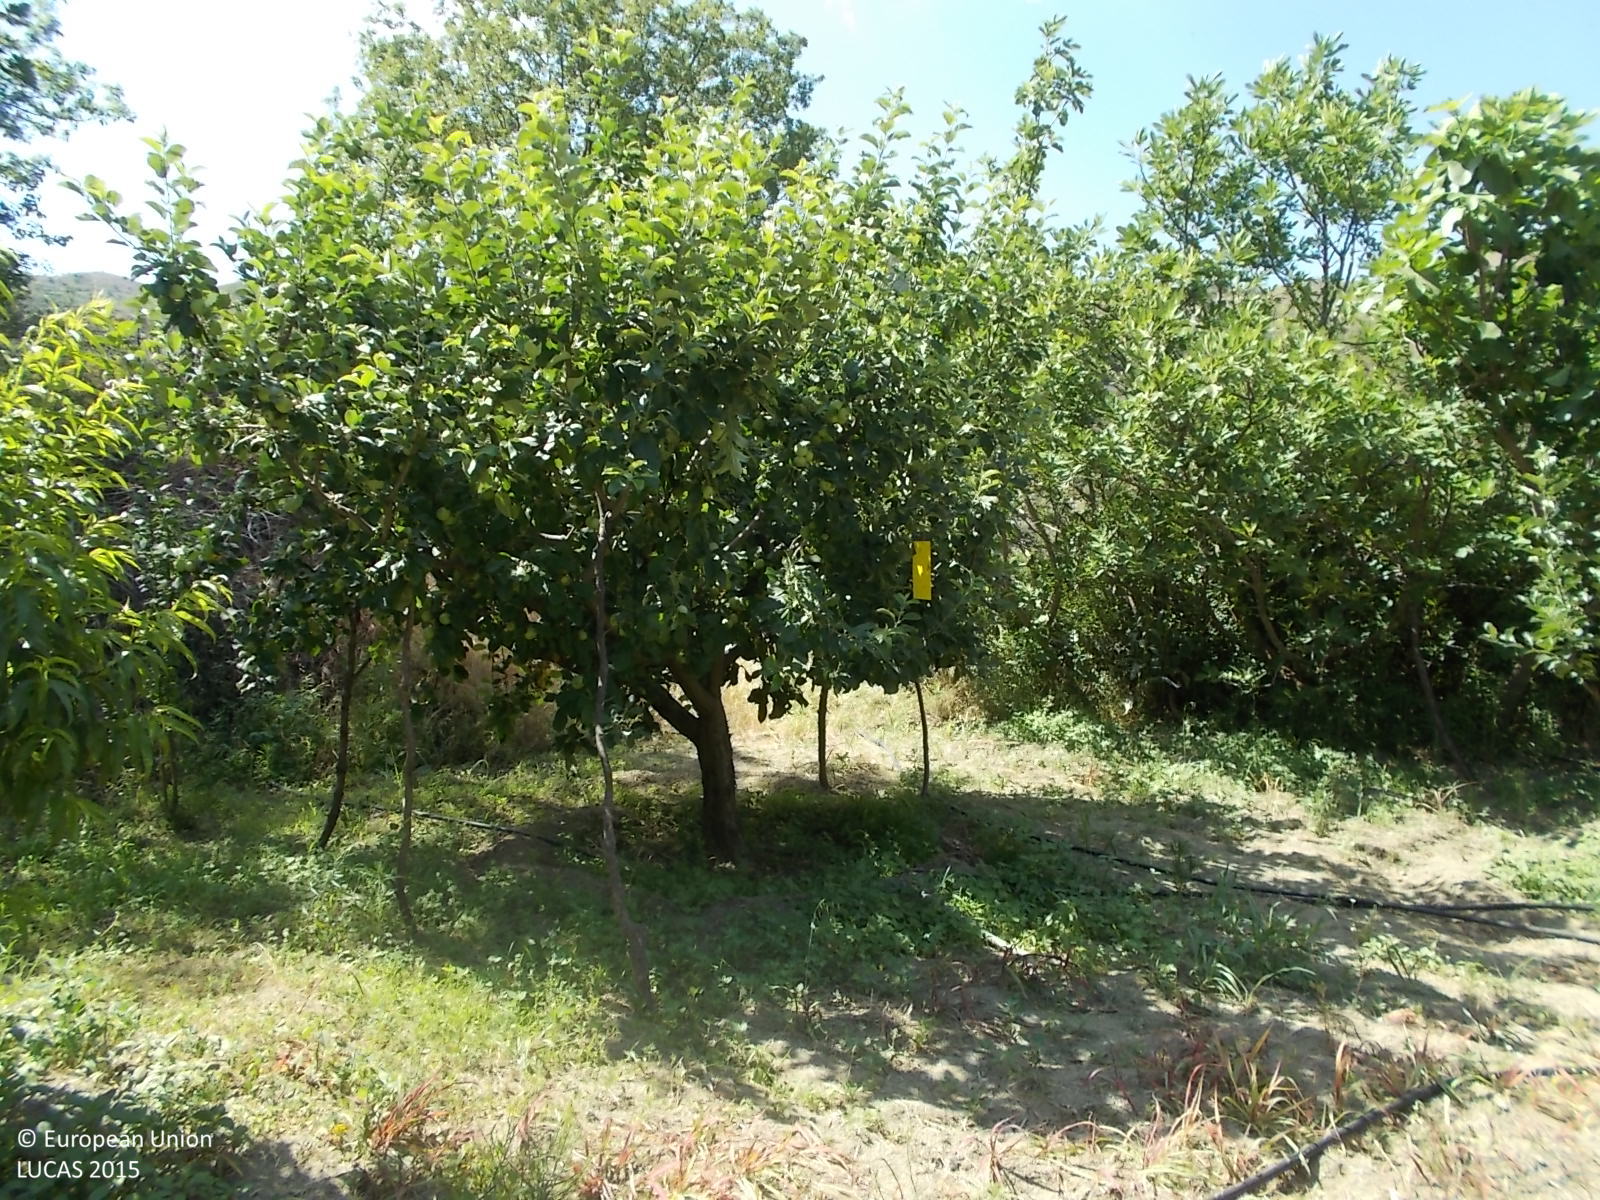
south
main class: Cropland
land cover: Apple fruit
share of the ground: 25 - 50 %
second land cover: Grassland without tree/shrub cover
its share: 50 - 75 %
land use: Agriculture (excluding fallow land and kitchen gardens)
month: June
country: CY
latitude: 34.8945
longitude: 32.8260
